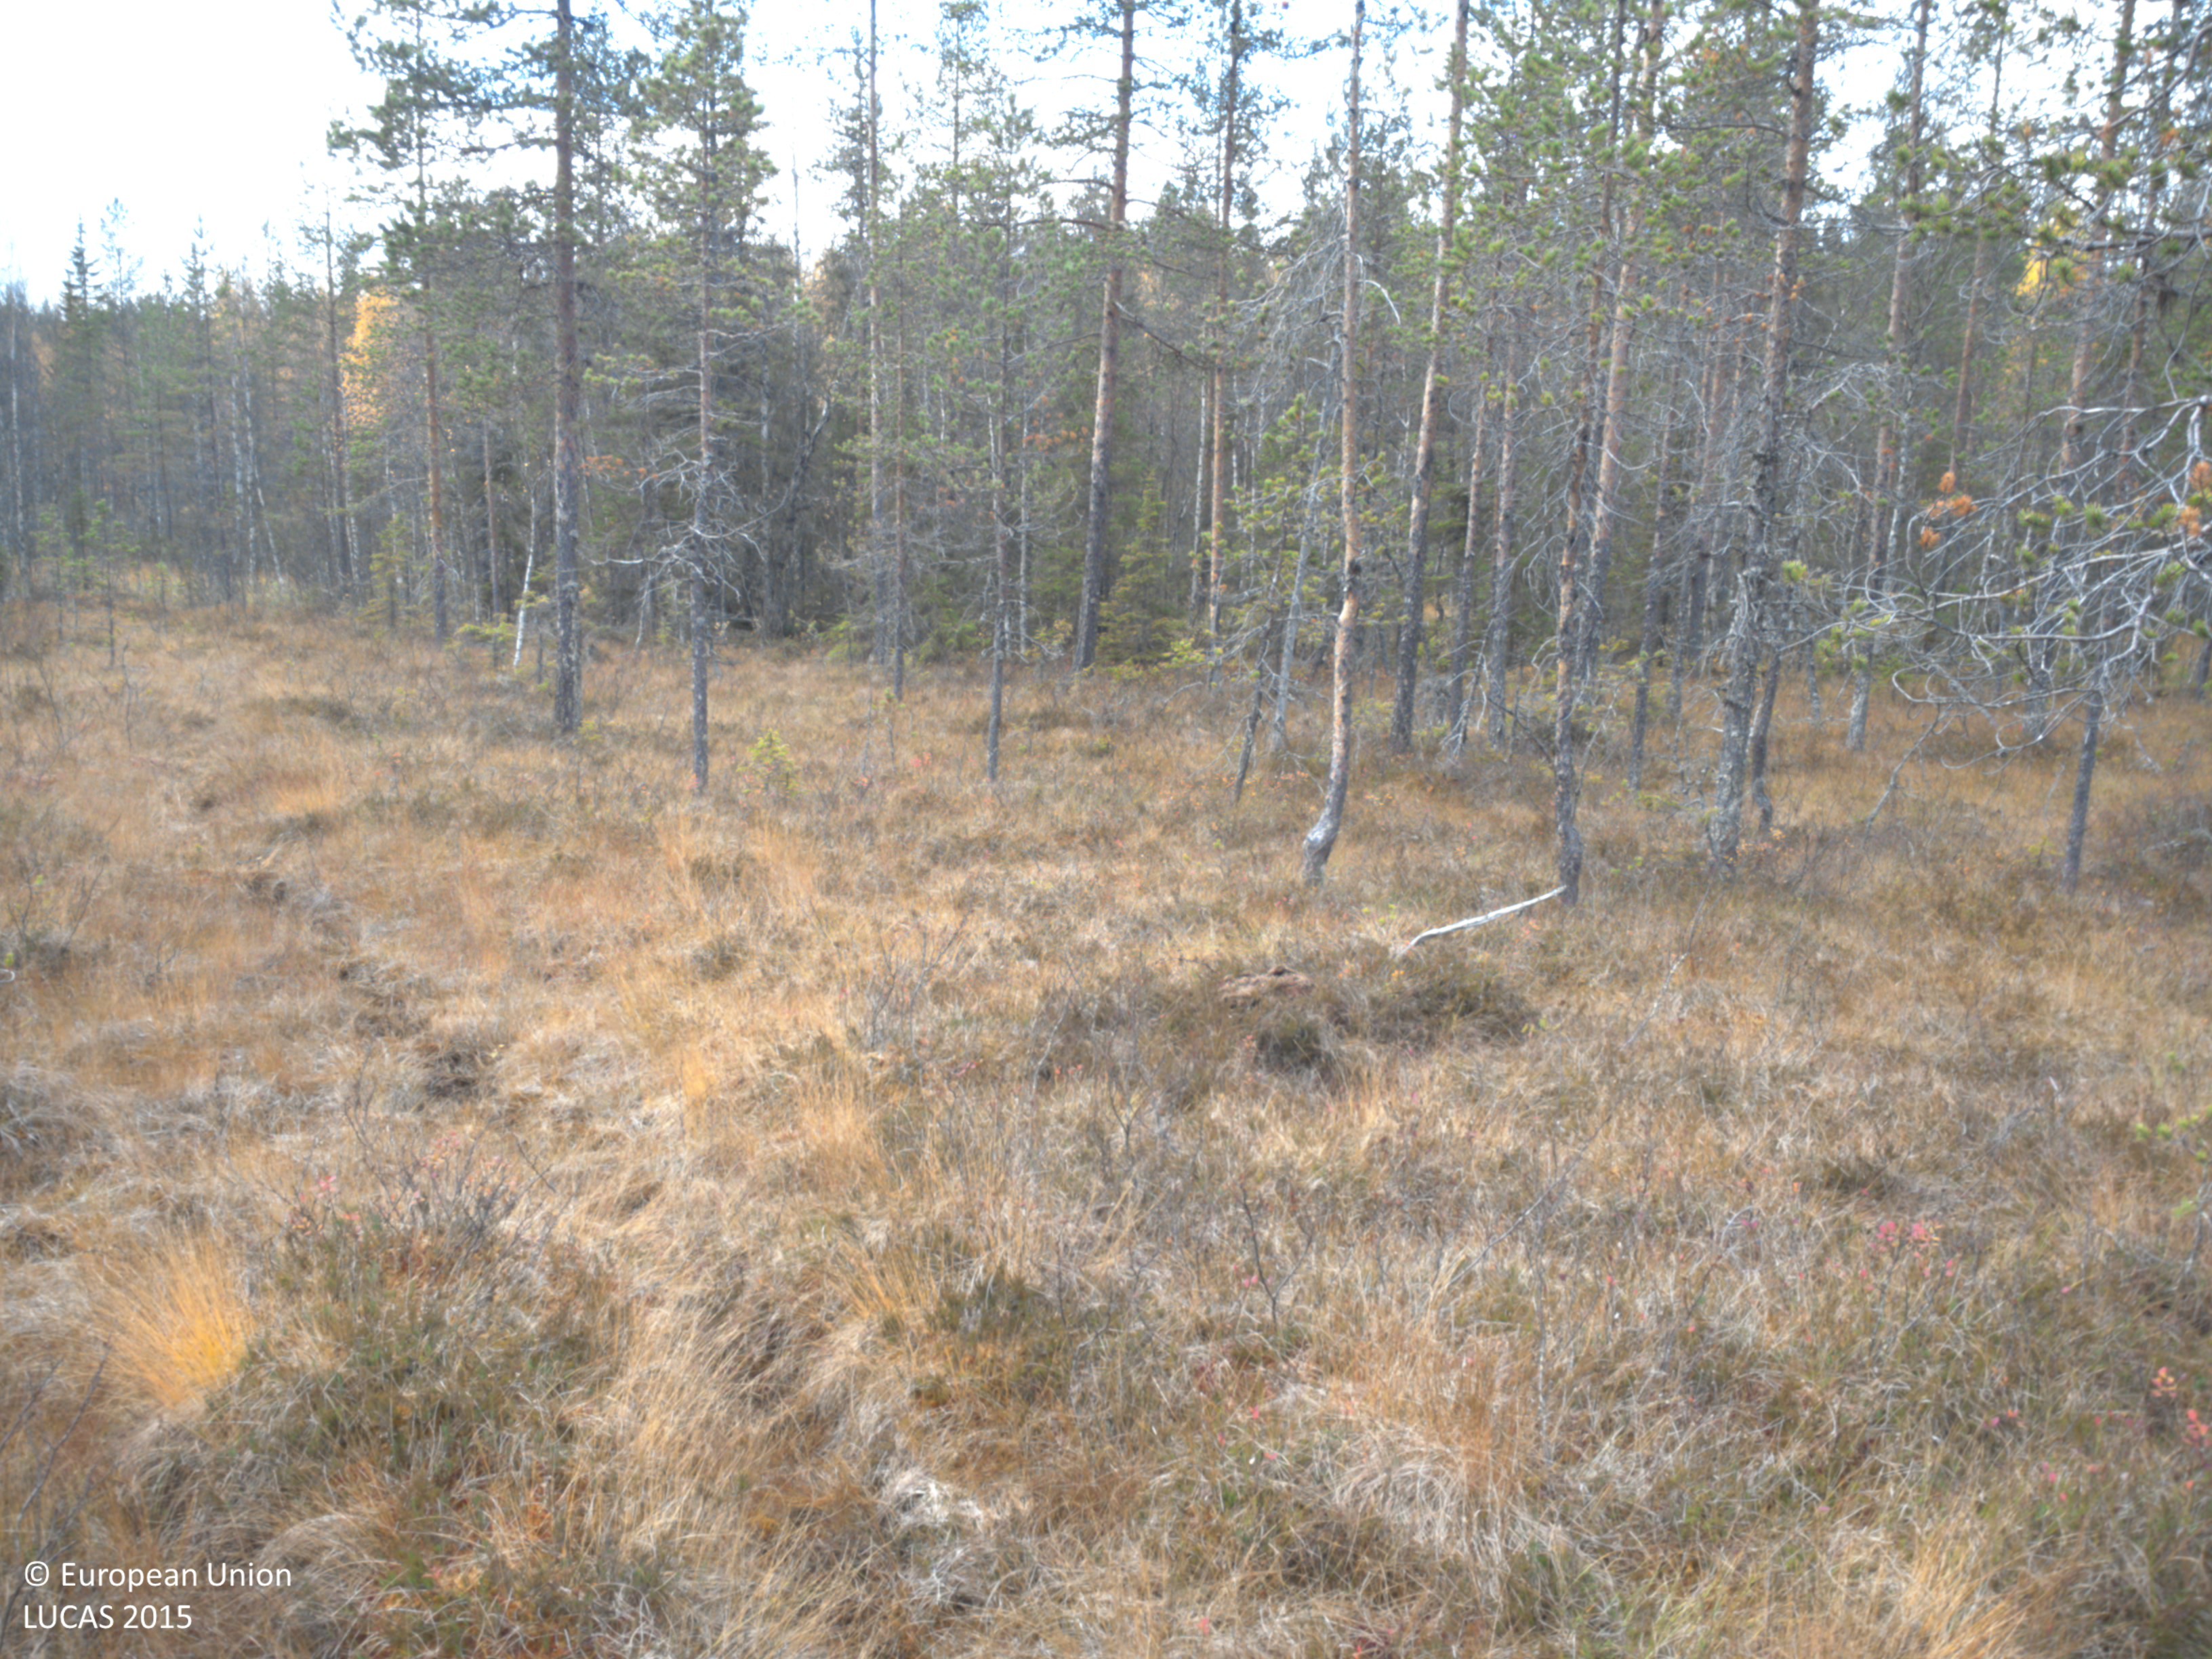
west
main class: Woodland
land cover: Pine dominated coniferous woodland
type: mire and swamp forests
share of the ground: 10 - 25 %
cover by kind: coniferous forest trees 30 %, shrubs 30 %, herbaceous plants 30 %, lichens and mosses 10 %
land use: Semi-natural and natural areas not in use
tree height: < 5 m
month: September
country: SE
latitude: 65.0015
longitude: 18.5961
